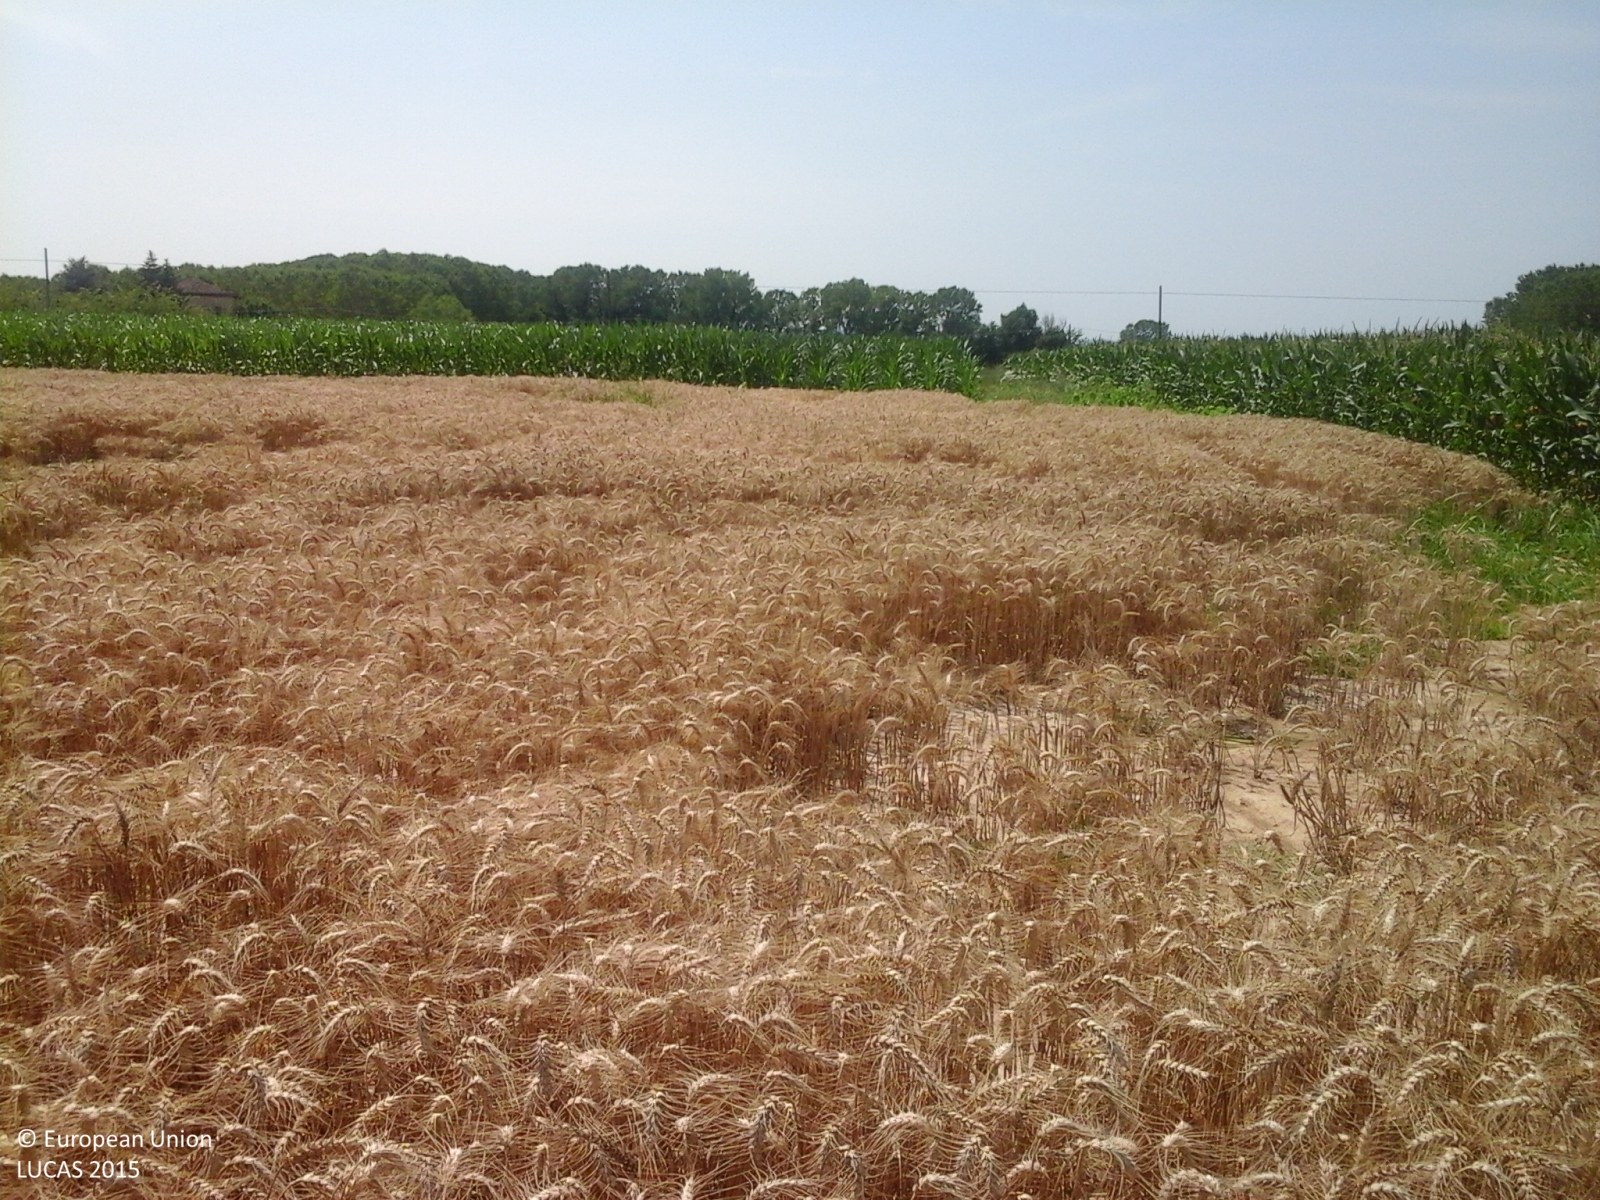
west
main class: Cropland
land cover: Common wheat
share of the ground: > 75 %
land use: Agriculture (excluding fallow land and kitchen gardens)
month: June
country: IT
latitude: 45.0253
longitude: 8.5179
